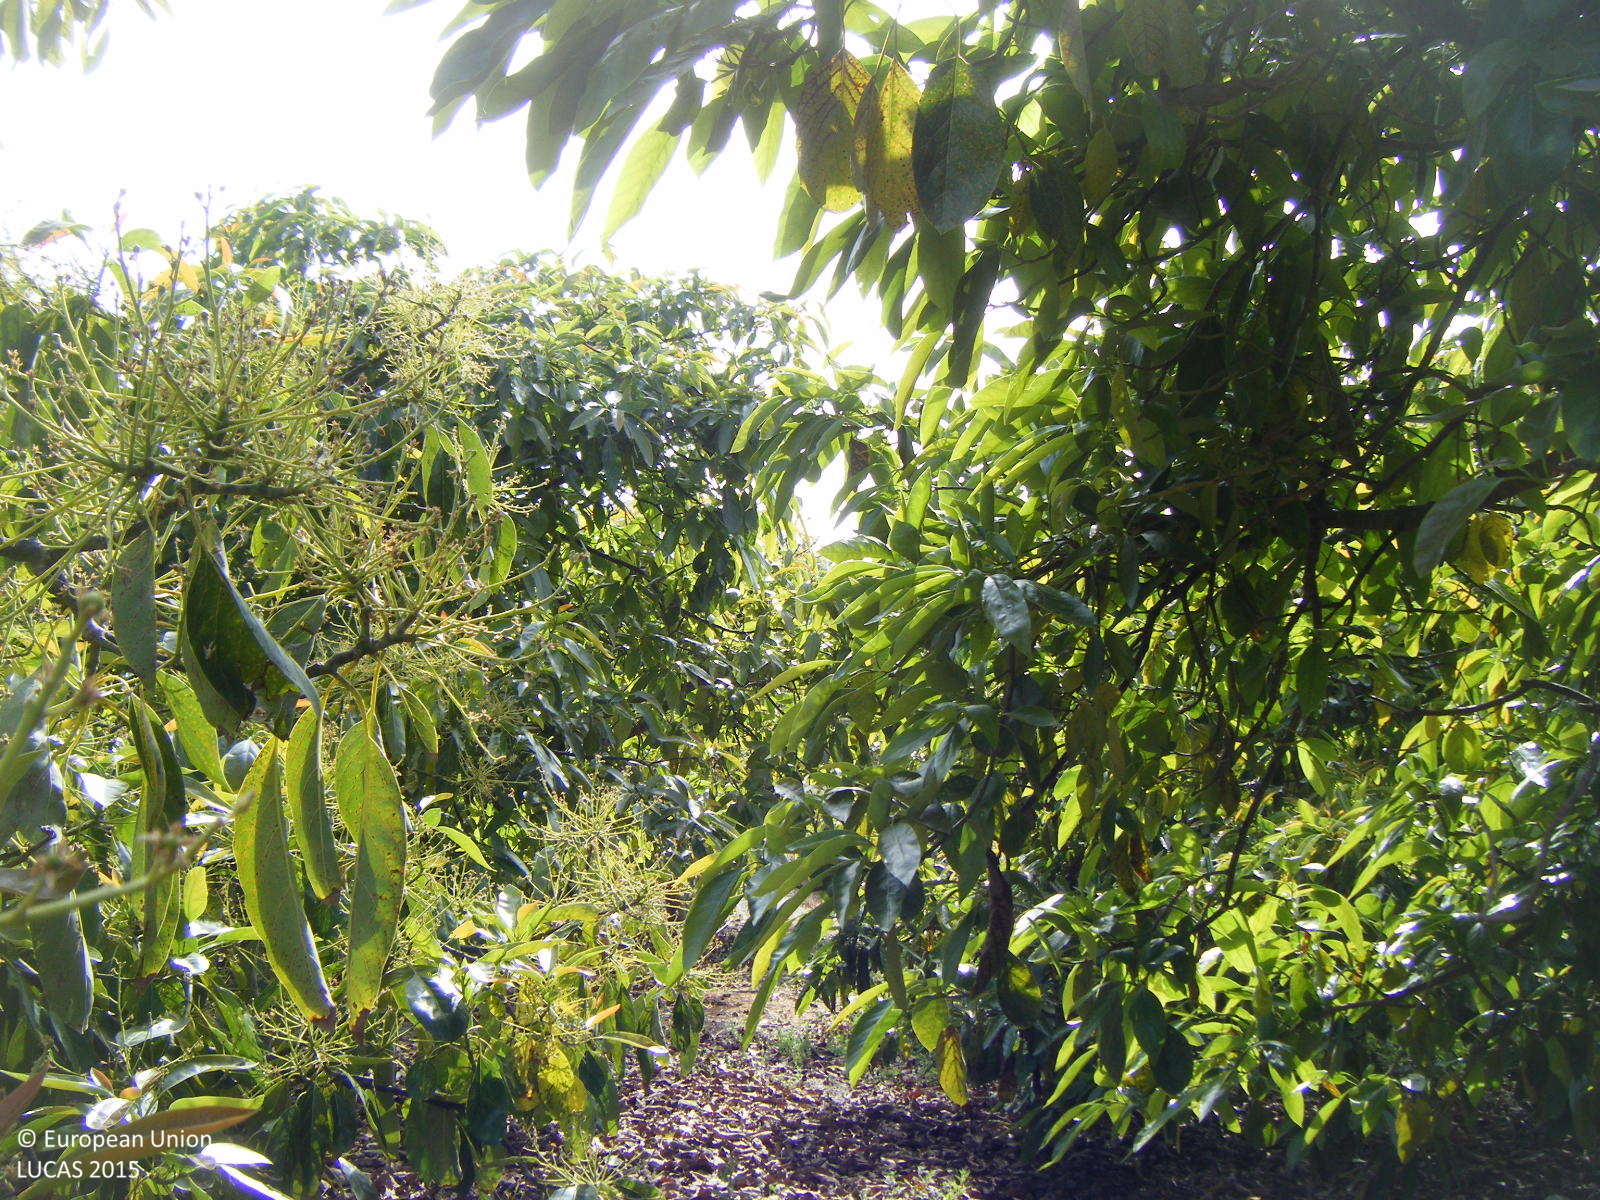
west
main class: Cropland
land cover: Other fruit trees and berries
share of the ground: 50 - 75 %
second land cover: Other bare soil
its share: > 75 %
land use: Agriculture (excluding fallow land and kitchen gardens)
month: May
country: ES
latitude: 36.7694
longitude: -4.0695
